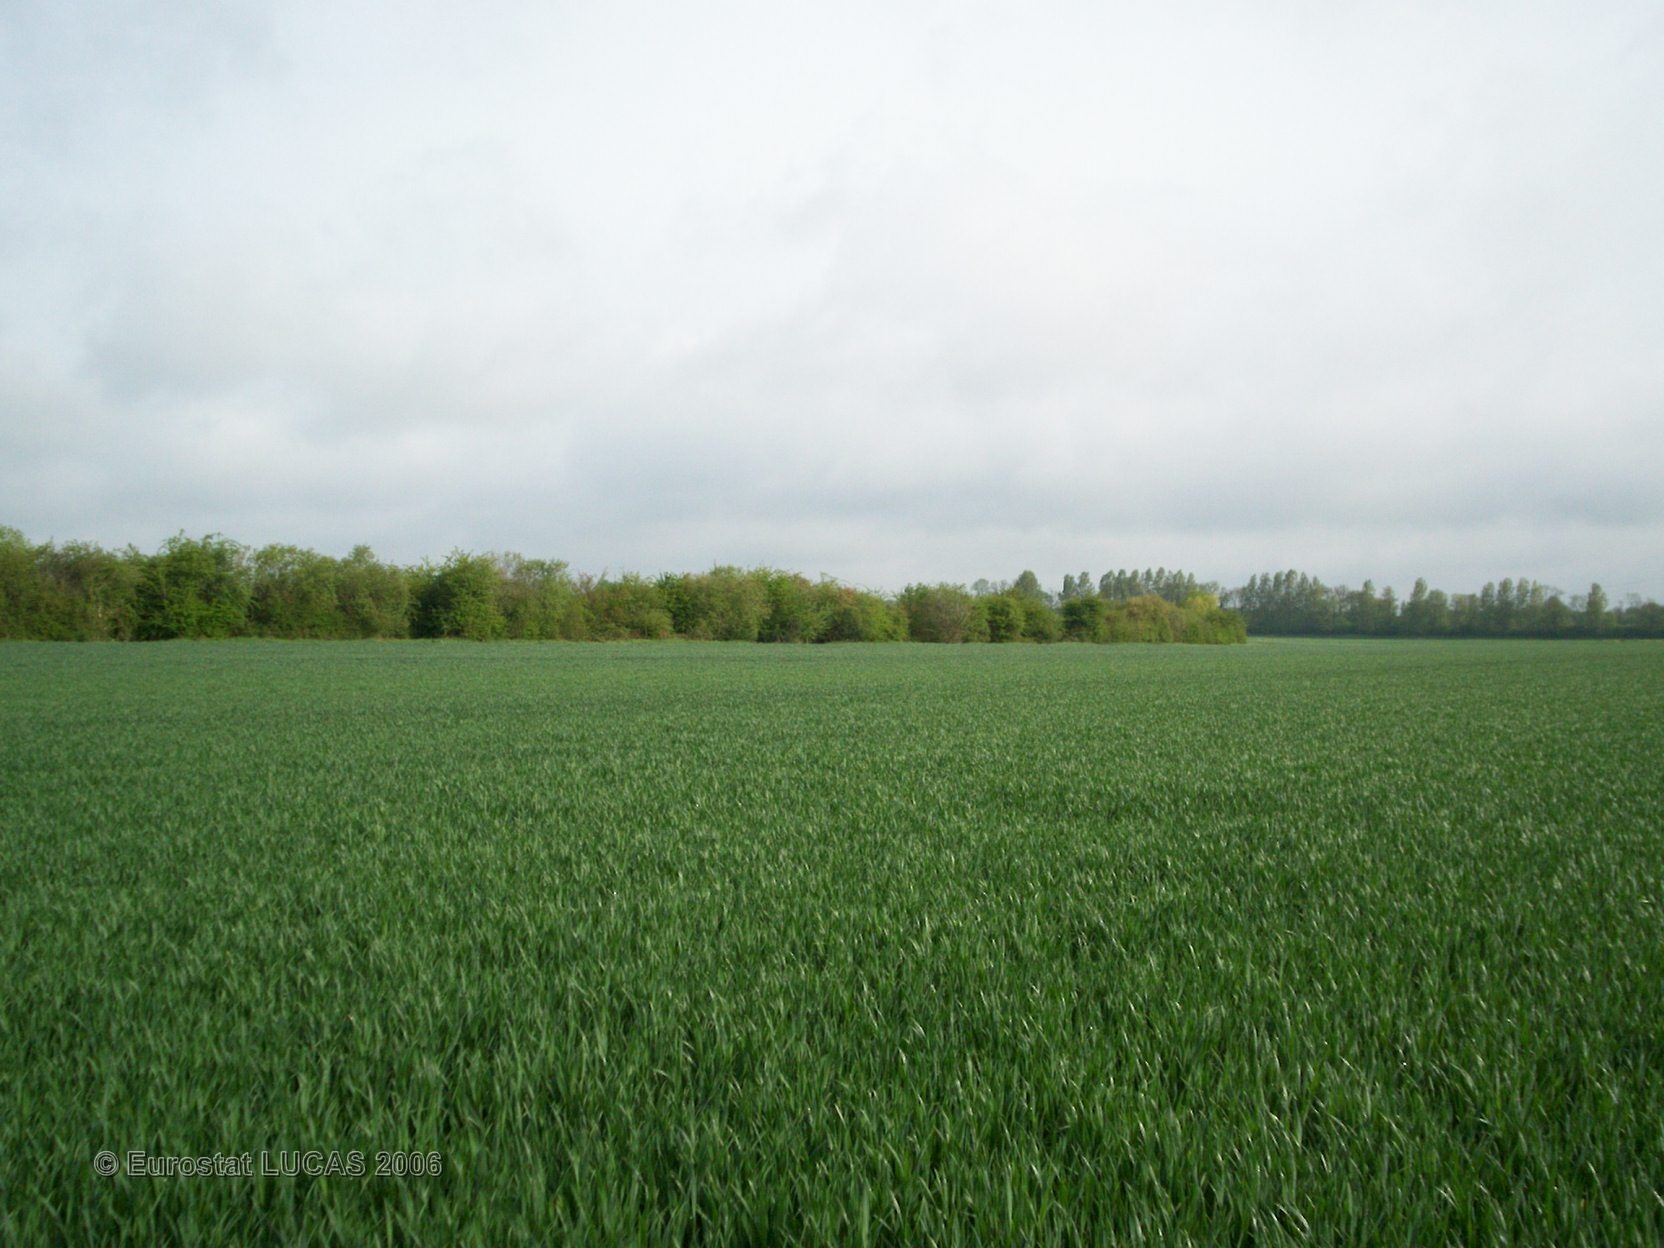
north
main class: Cropland
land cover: Common wheat
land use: Agriculture (excluding fallow land and kitchen gardens)
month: May
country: FR
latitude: 48.6260
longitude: 0.2721
